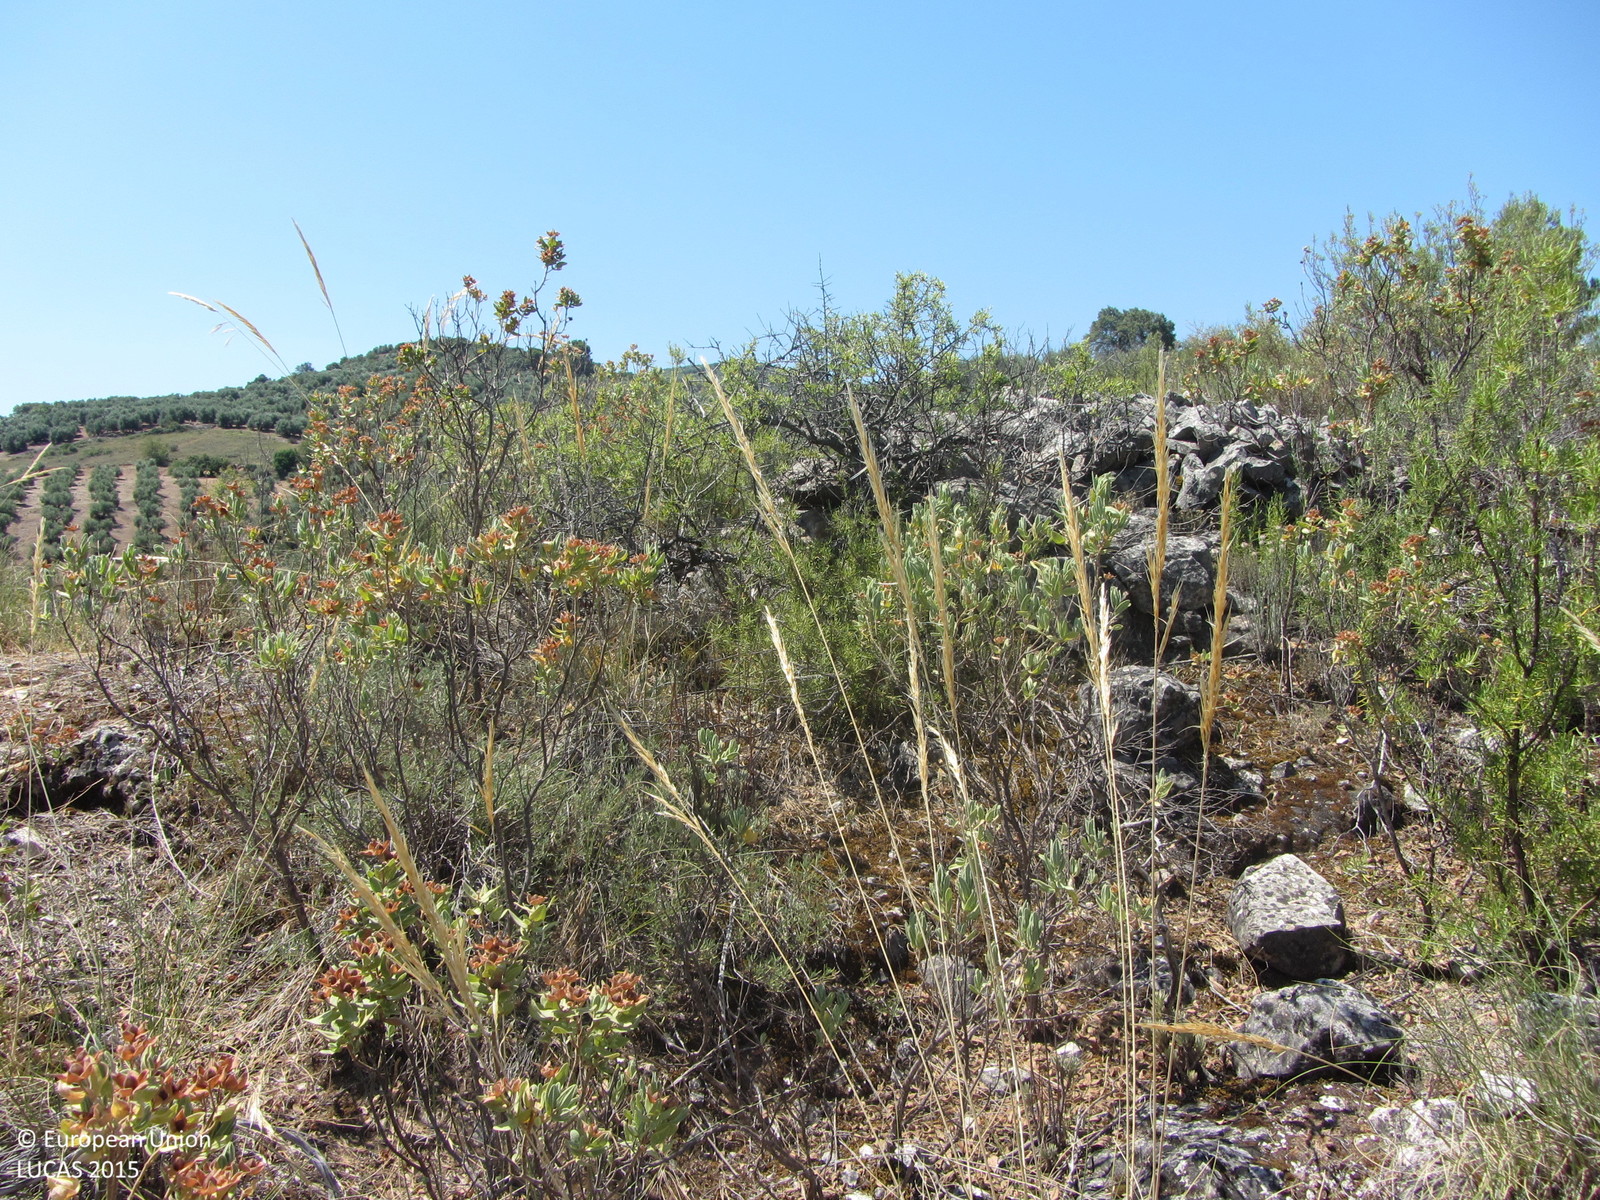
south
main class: Shrubland
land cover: Shrubland with sparse tree cover
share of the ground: > 75 %
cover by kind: shrubs 95 %, coniferous forest trees 5 %
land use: Semi-natural and natural areas not in use
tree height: < 5 m
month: June
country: ES
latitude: 38.2432
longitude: -2.8757
